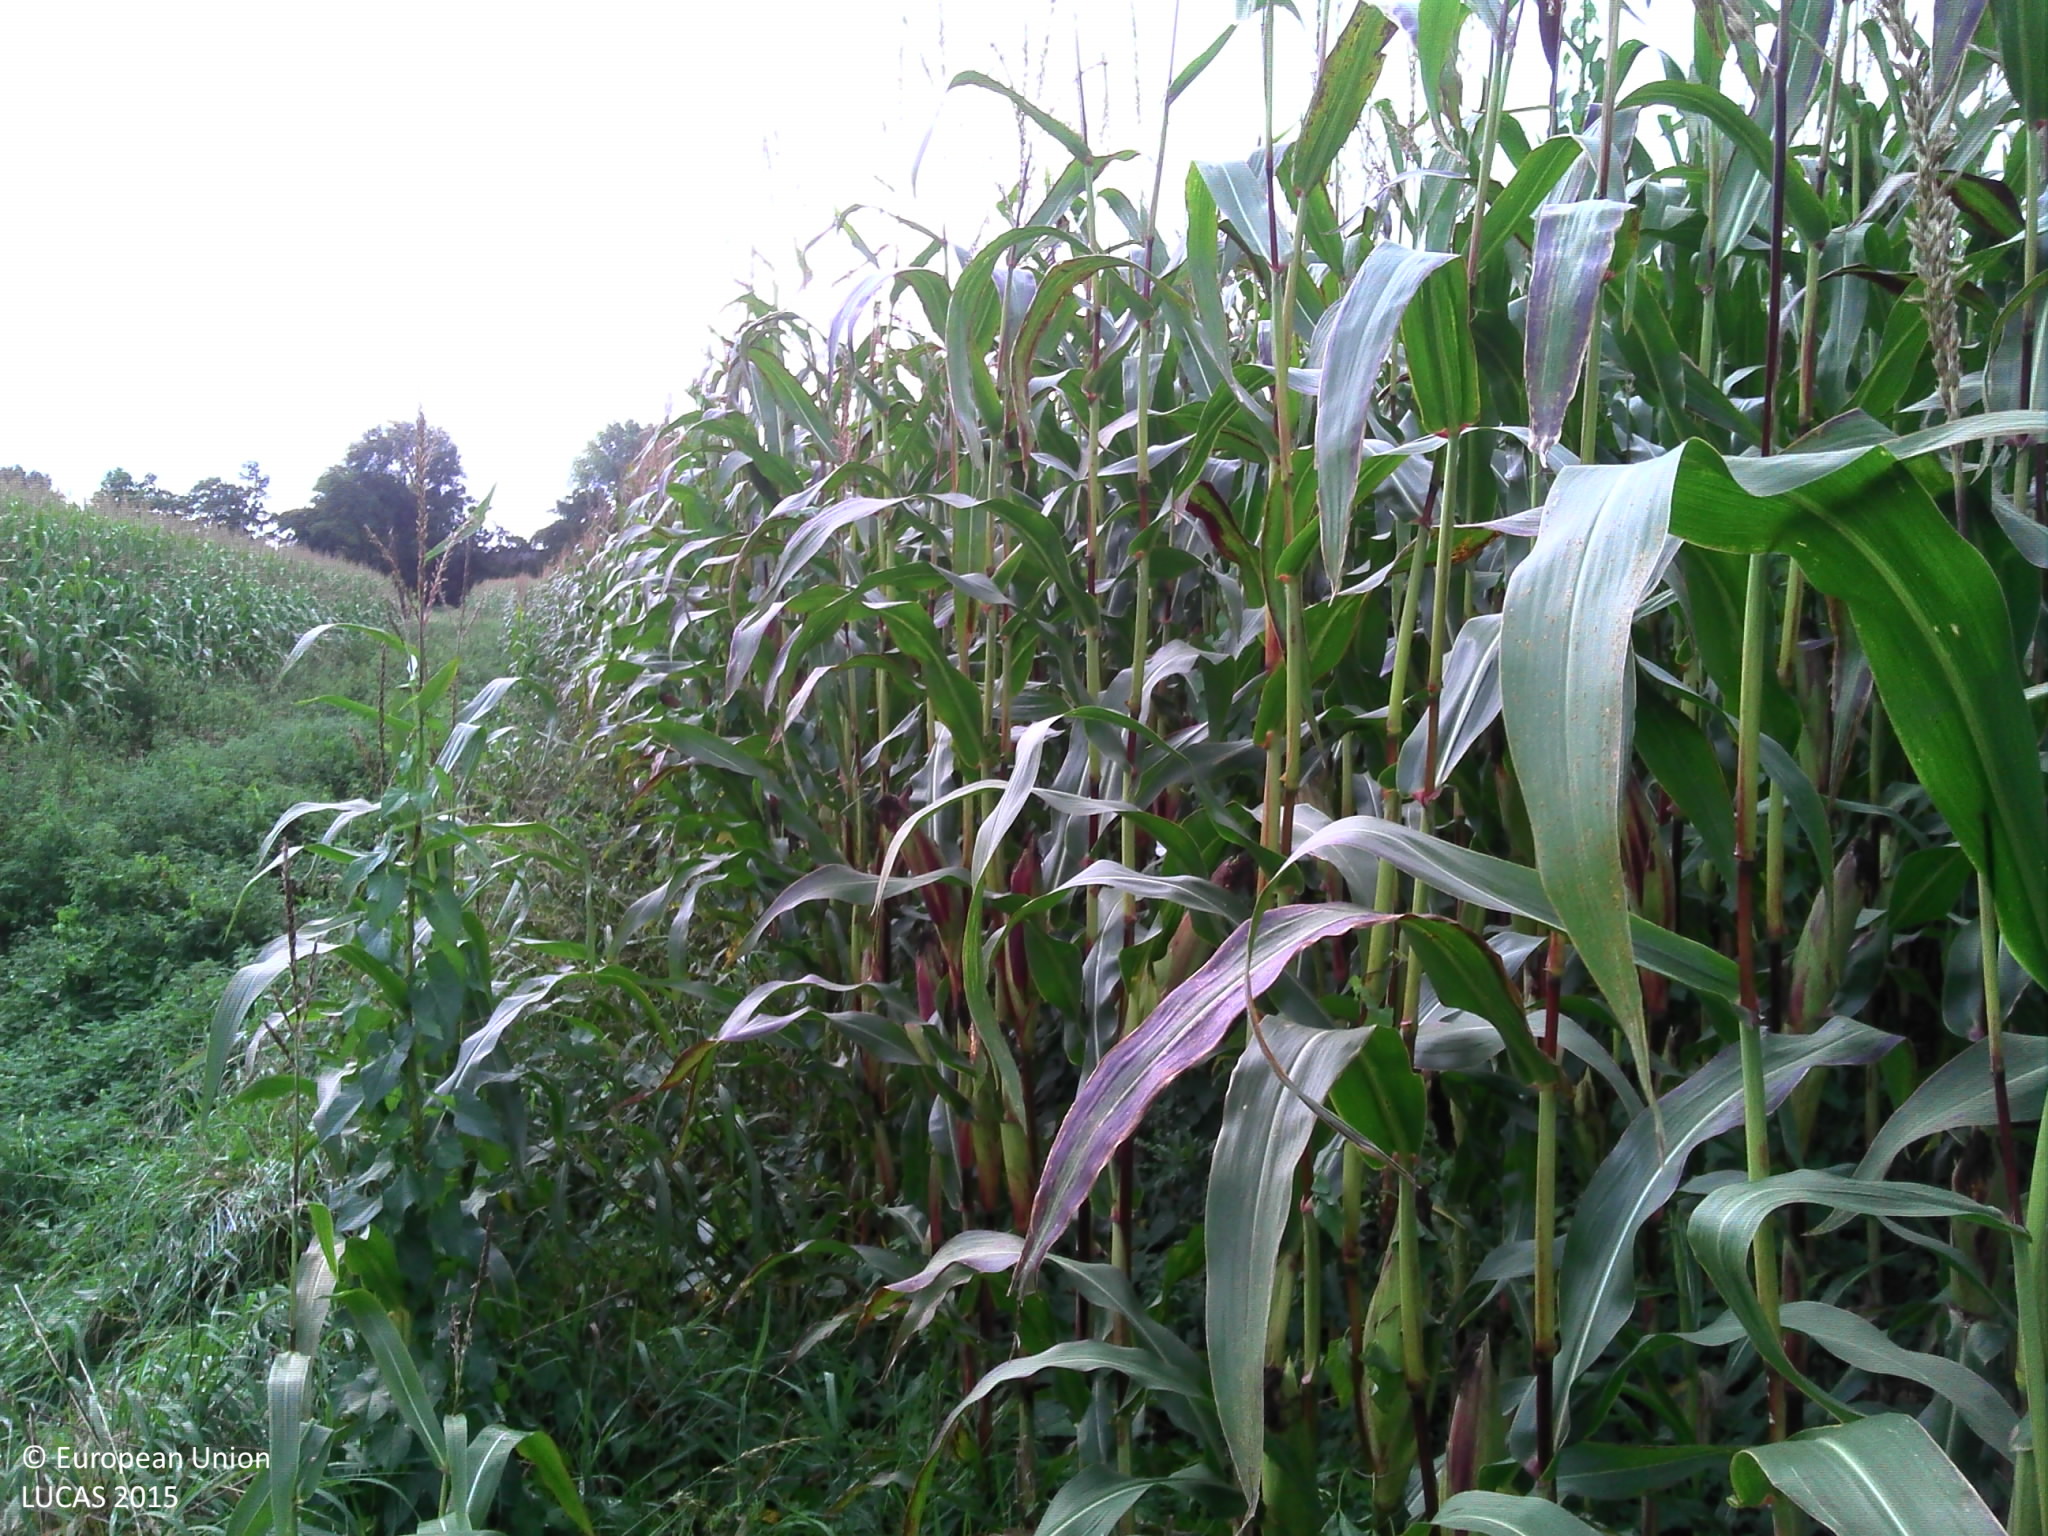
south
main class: Cropland
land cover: Maize
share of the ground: > 75 %
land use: Agriculture (excluding fallow land and kitchen gardens)
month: September
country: BE
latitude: 51.1271
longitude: 4.3799
